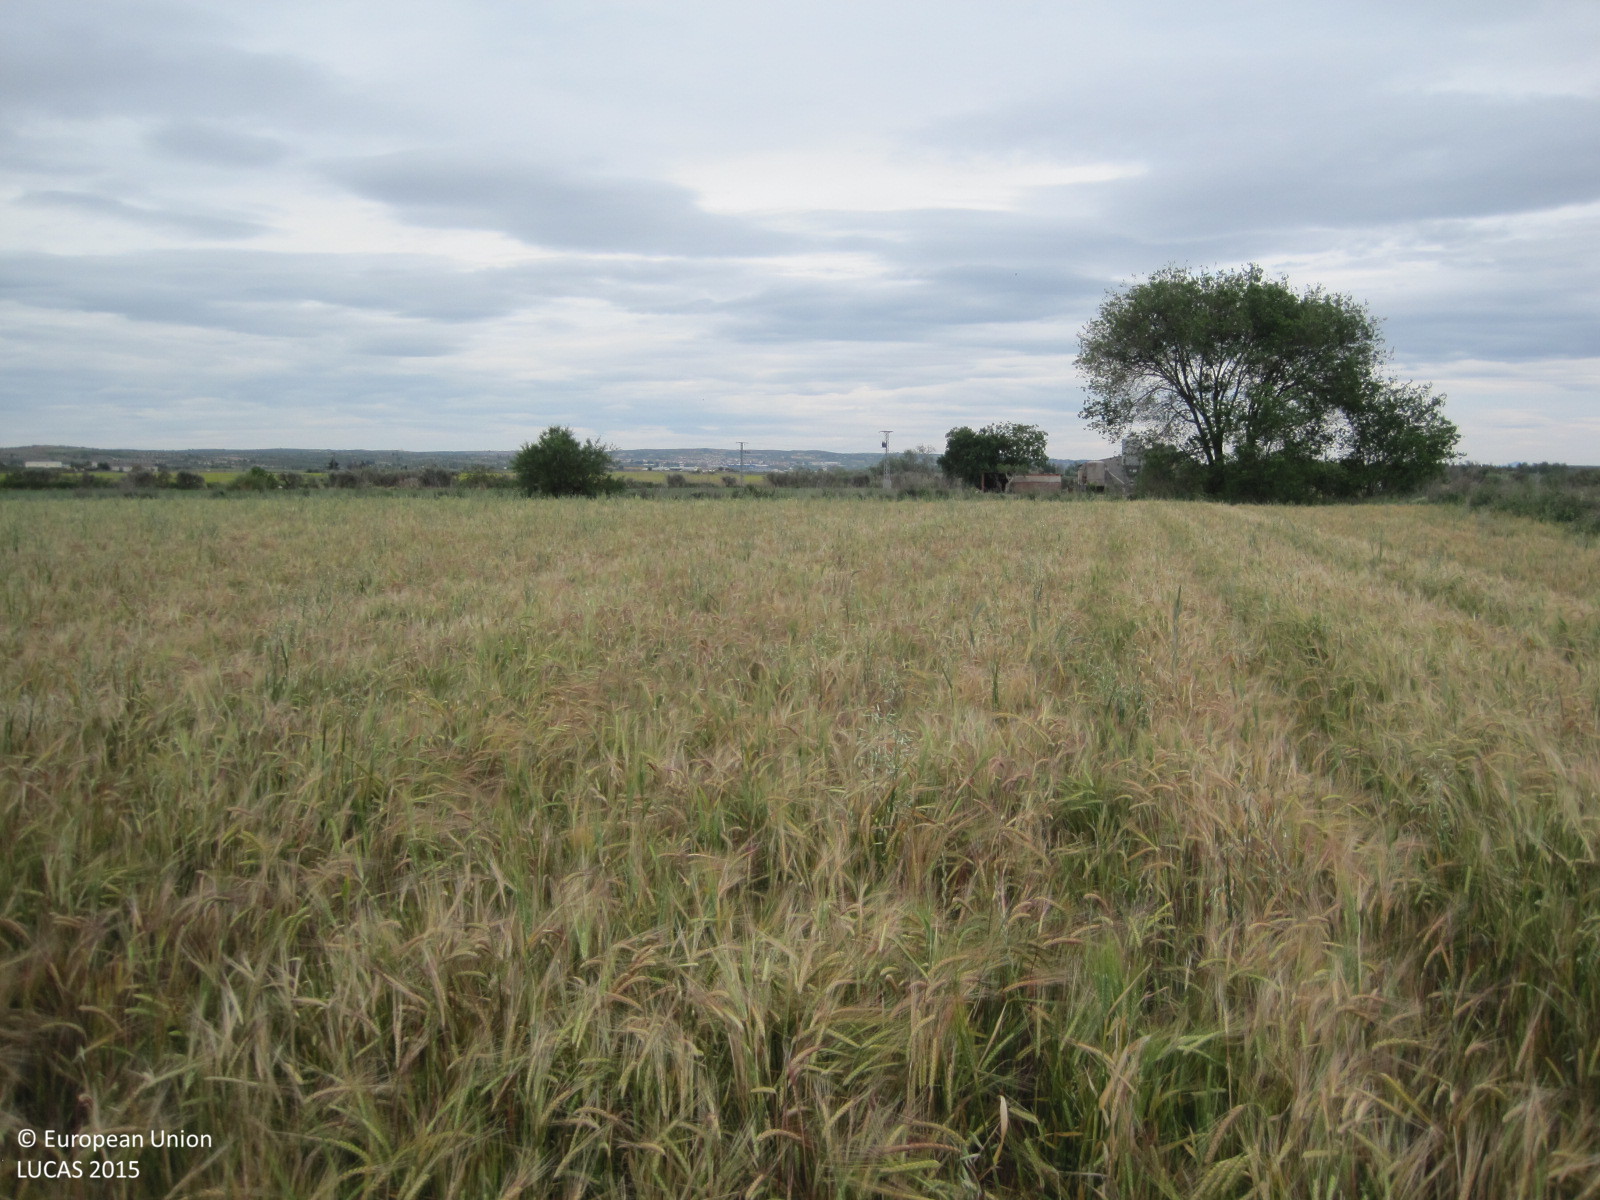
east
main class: Cropland
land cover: Mixed cereals for fodder
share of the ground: > 75 %
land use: Agriculture (excluding fallow land and kitchen gardens)
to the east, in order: Mixed cereals for fodder; Grass margins; Grassland without tree/shrub cover; Grass margins; Paved roads, cycling and walking lanes; Grass margins; Grassland without tree/shrub cover; Grass margins; Dry pulses
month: May
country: ES
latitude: 39.9481
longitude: -4.6638
